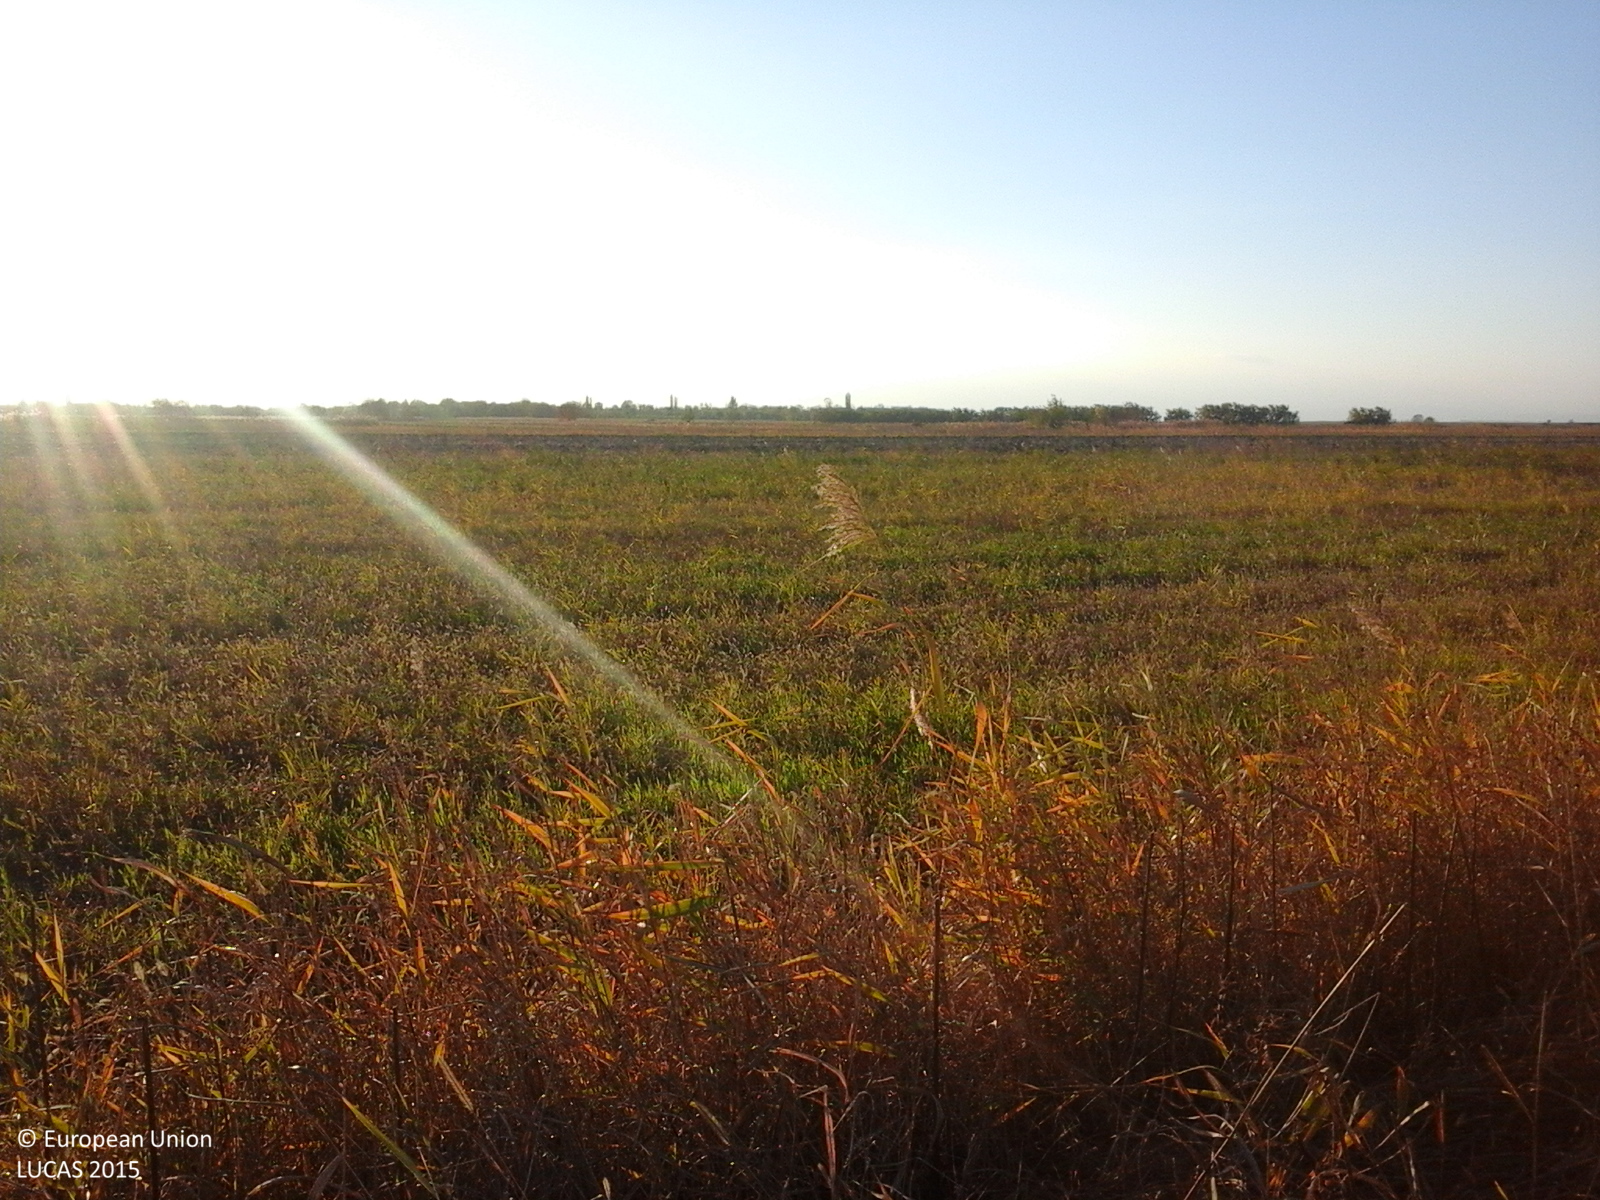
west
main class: Cropland
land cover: Sunflower
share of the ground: > 75 %
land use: Agriculture (excluding fallow land and kitchen gardens)
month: October
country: RO
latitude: 45.3977
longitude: 27.4608
